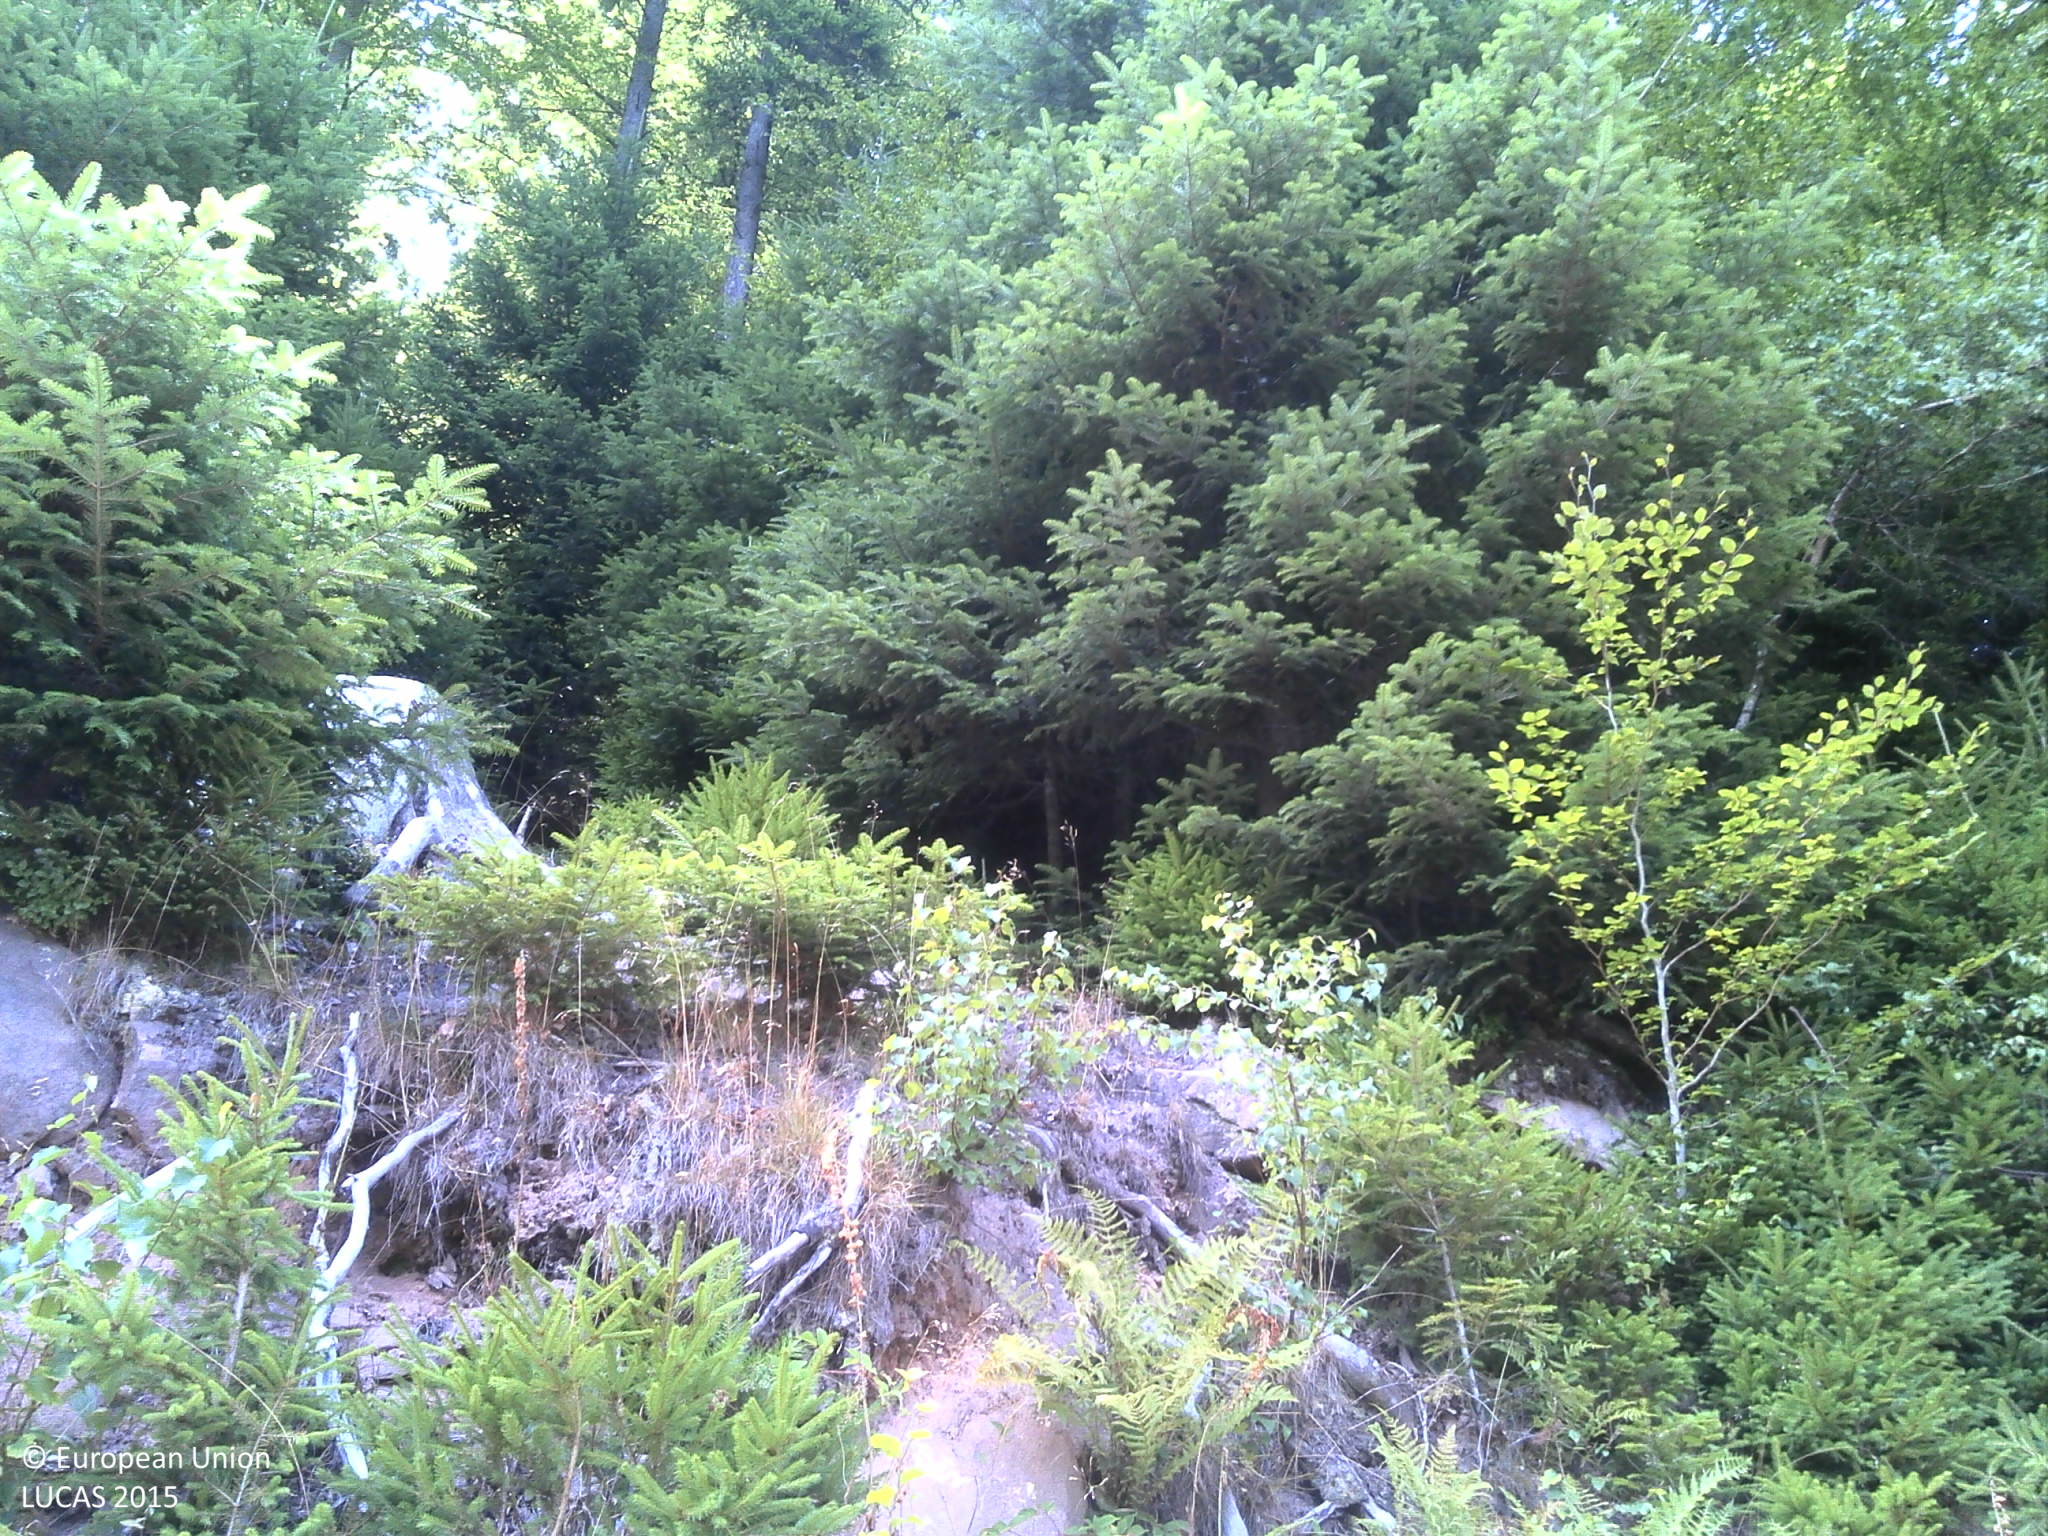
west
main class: Woodland
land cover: Spruce dominated mixed woodland
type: hemiboreal forest and nemoral coniferous forest and mixed broadleaved-coniferous forest
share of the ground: > 75 %
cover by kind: coniferous forest trees 40 %, broadleaved forest trees 40 %, shrubs 10 %, herbaceous plants 10 %
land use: Forestry
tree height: > 5 m
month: July
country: FR
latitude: 48.6219
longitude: 7.2739
